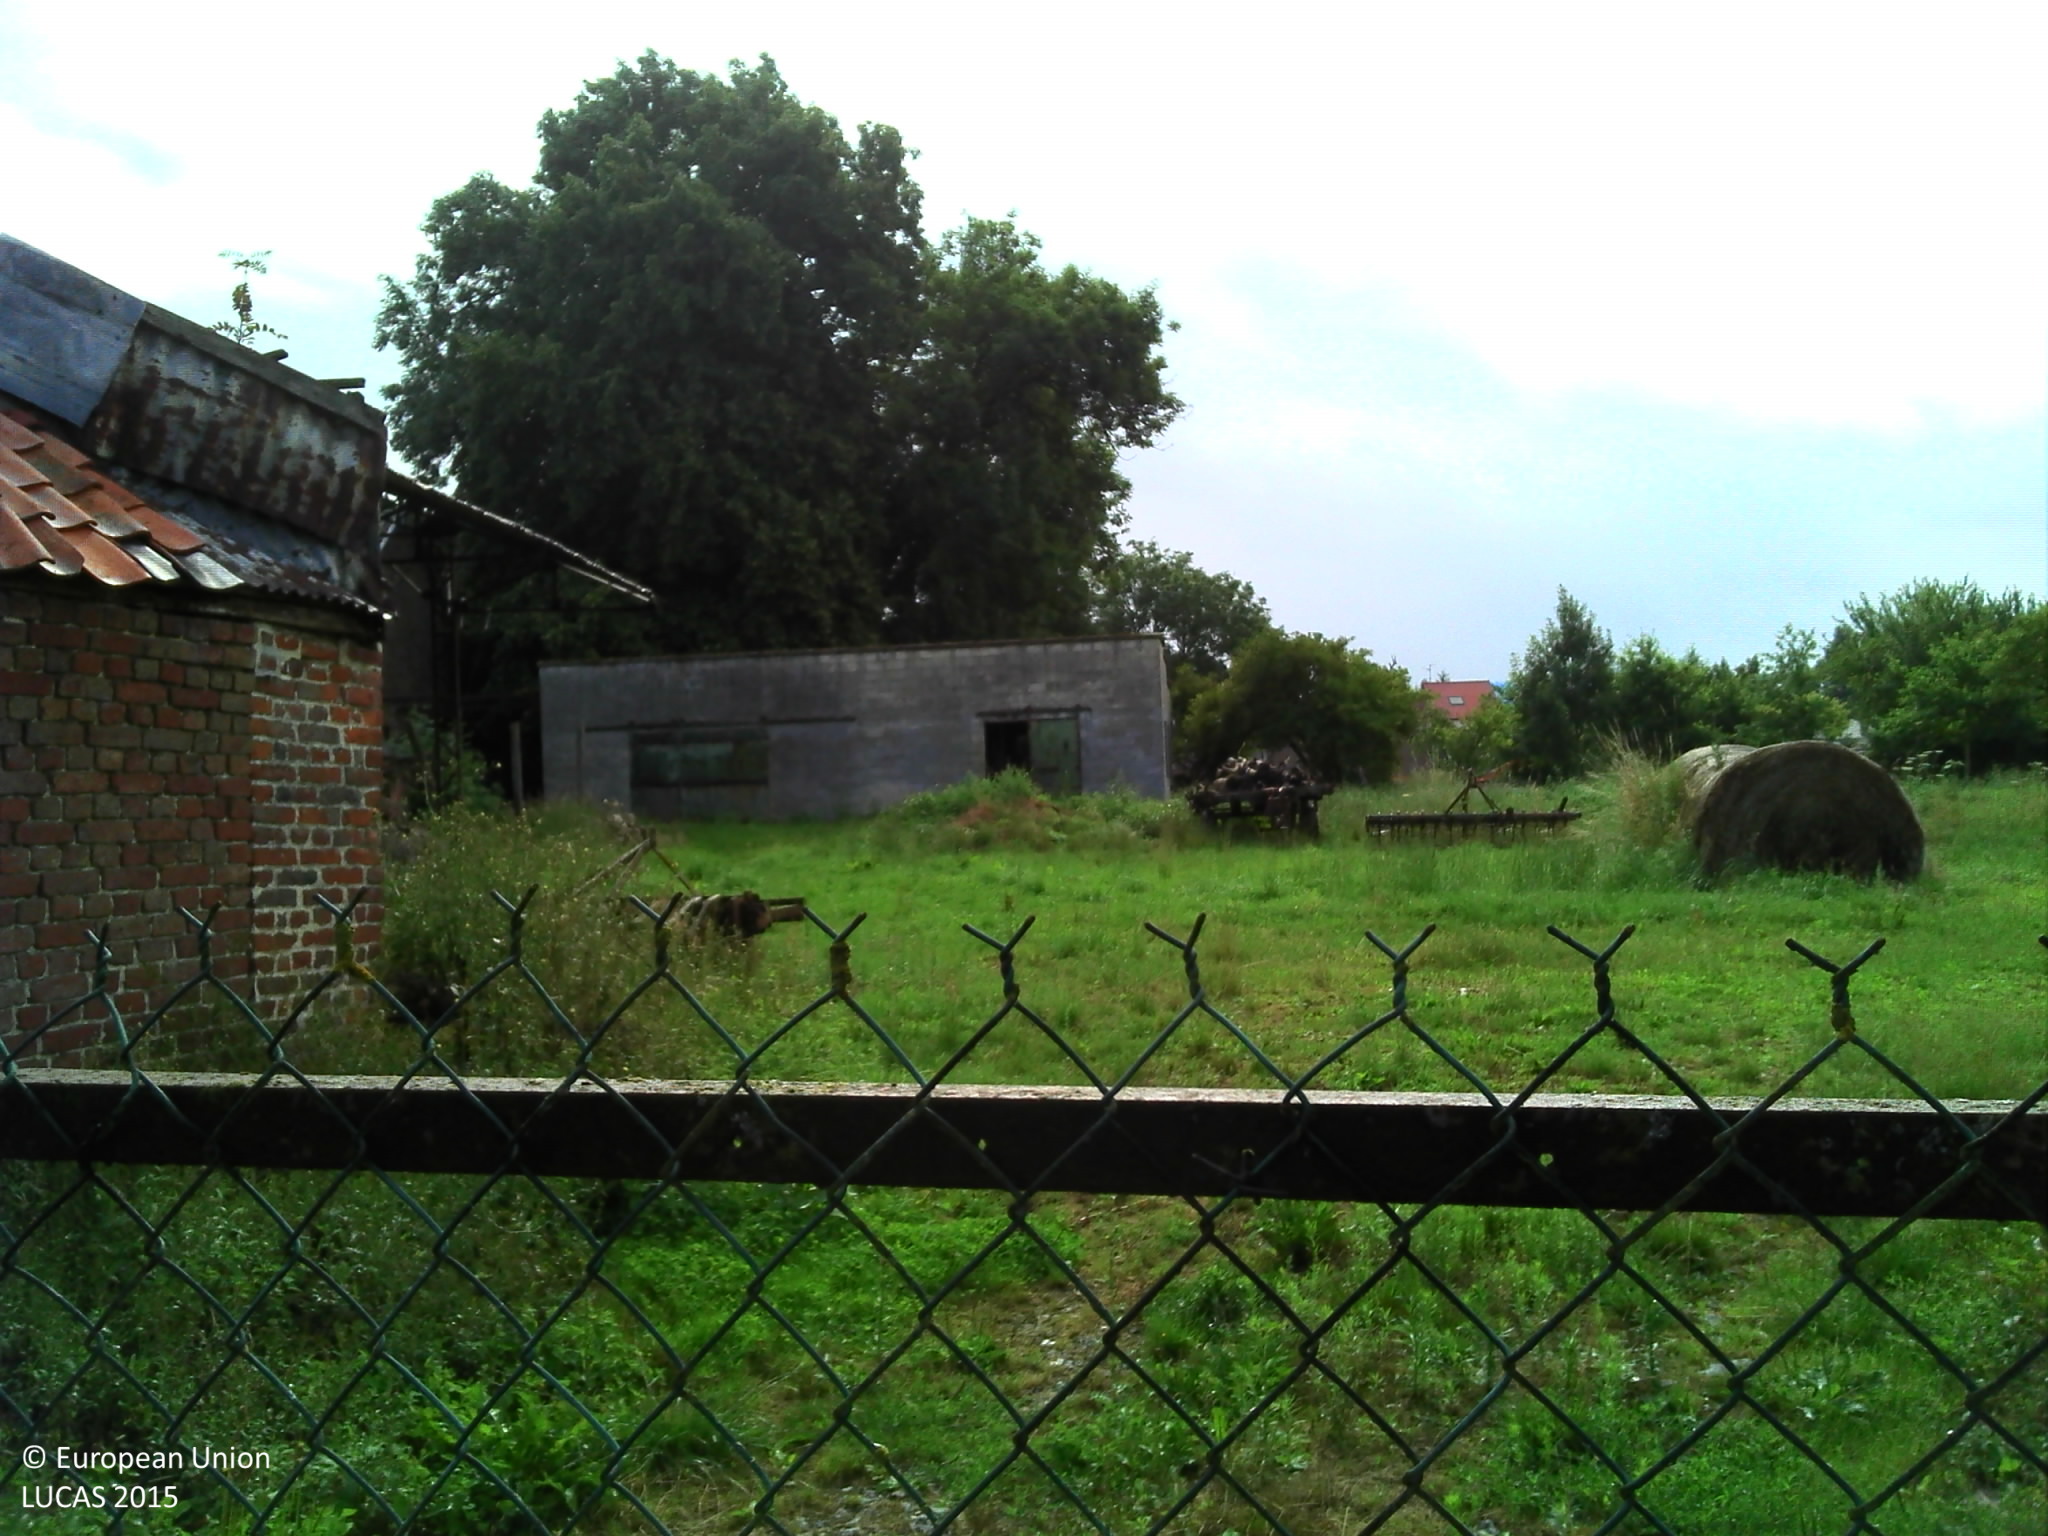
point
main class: Woodland
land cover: Broadleaved woodland
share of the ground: > 75 %
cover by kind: broadleaved forest trees 85 %, herbaceous plants 15 %
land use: Residential
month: July
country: FR
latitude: 50.3292
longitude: 3.6011
